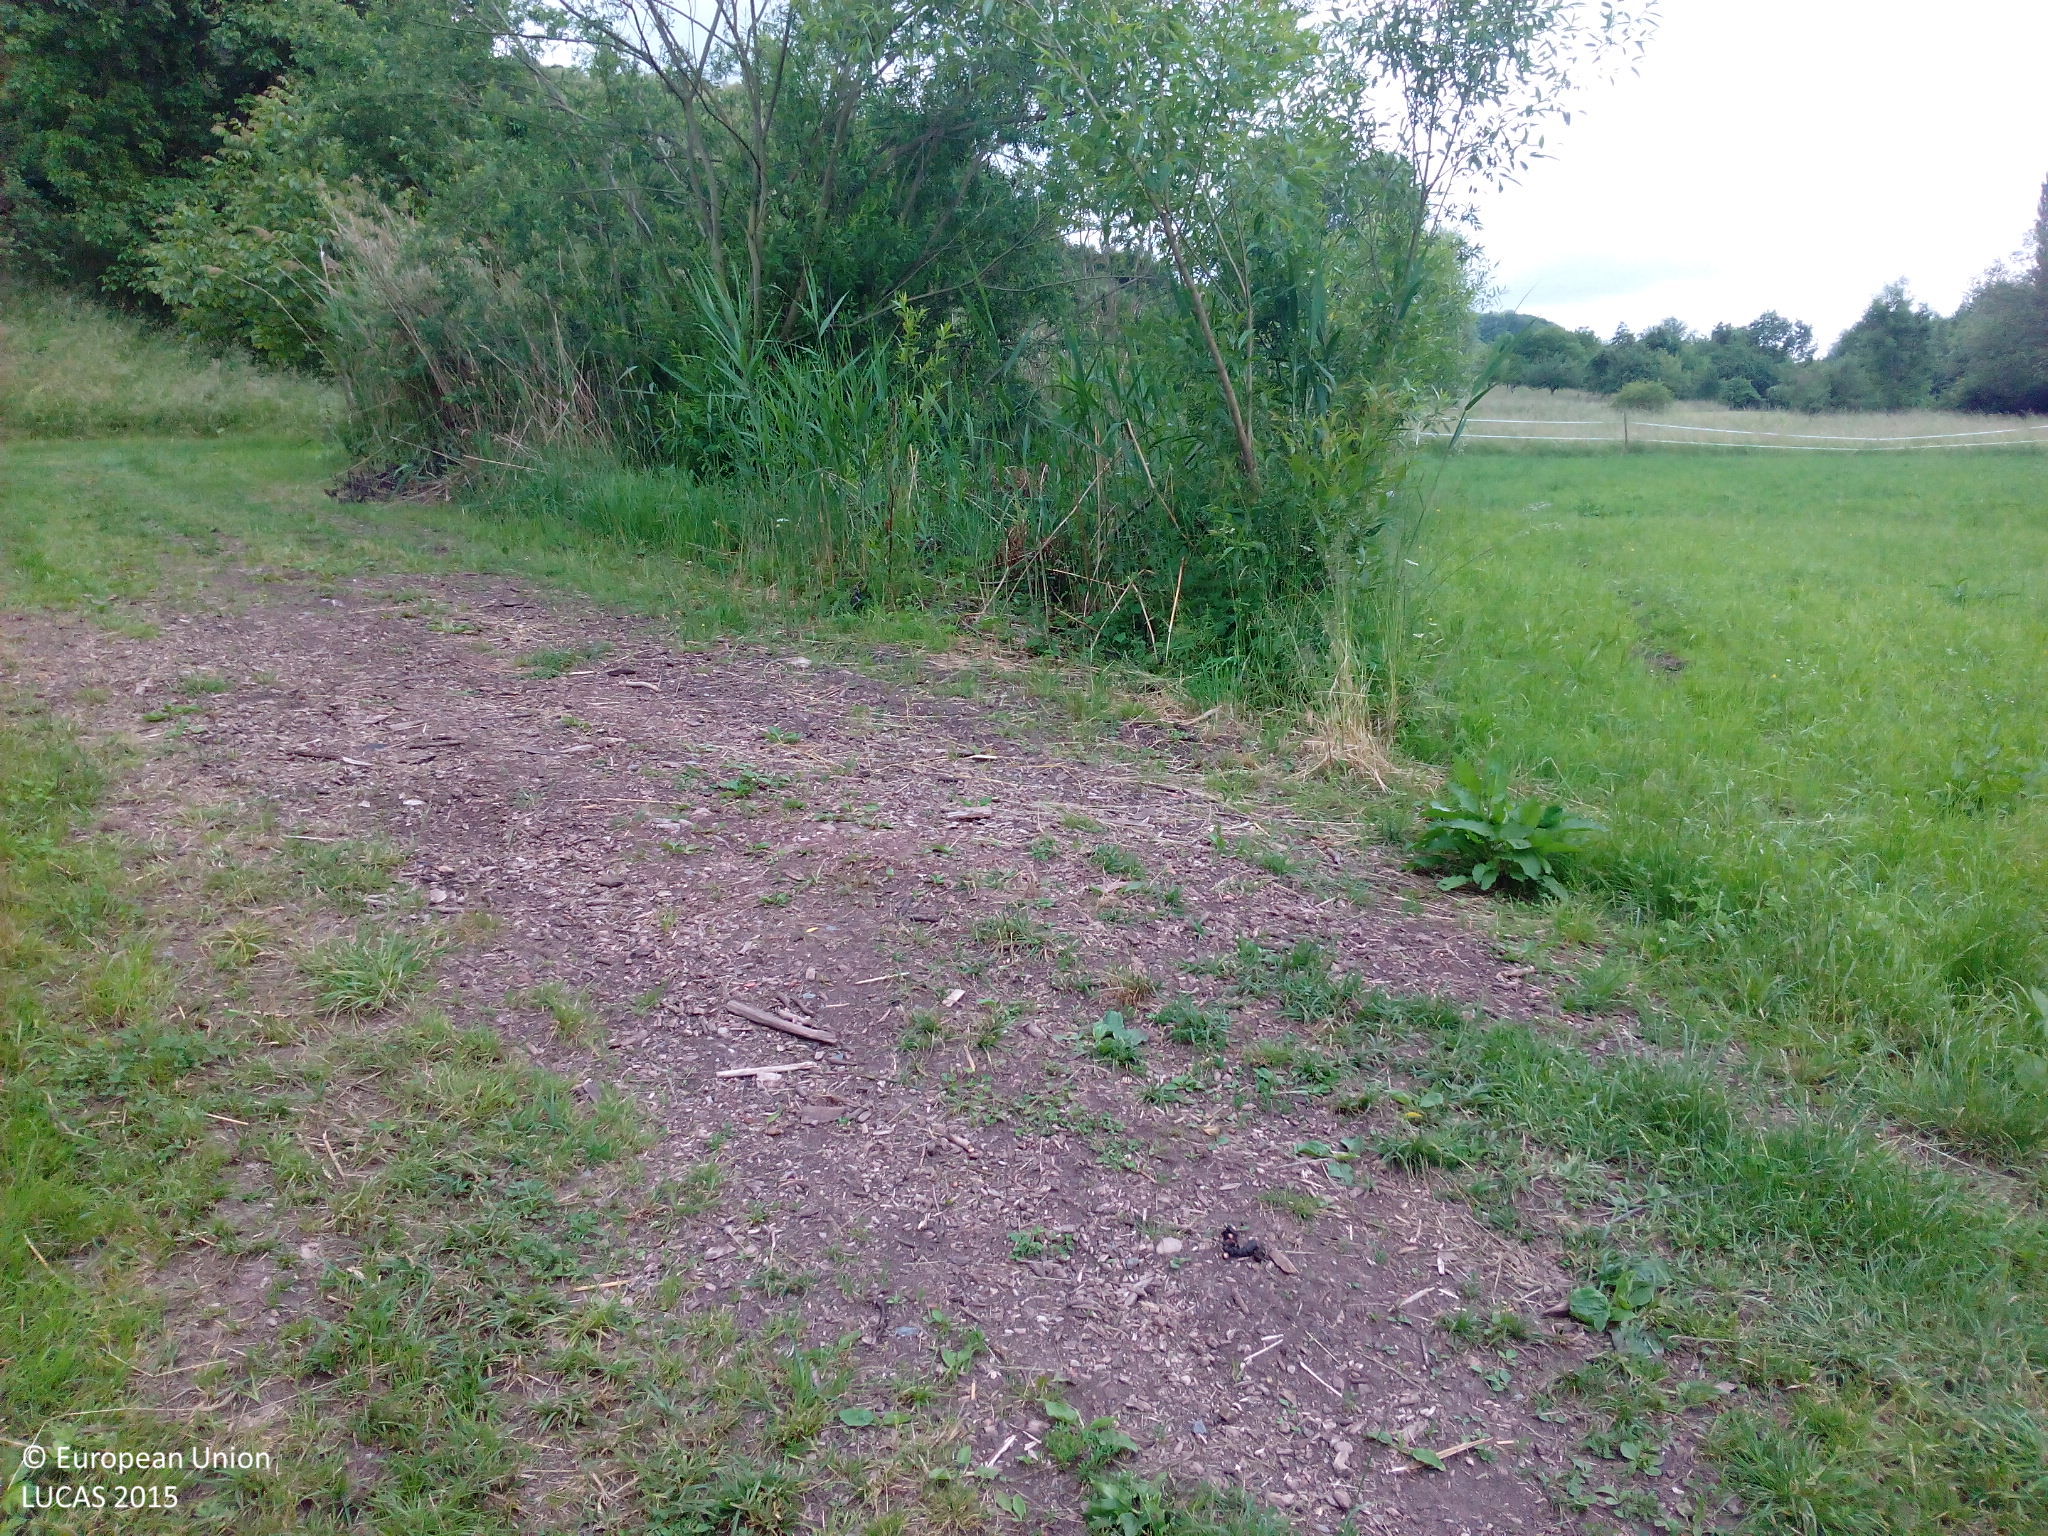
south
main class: Grassland
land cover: Grassland without tree/shrub cover
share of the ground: > 75 %
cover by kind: herbaceous plants 100 %
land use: Agriculture (excluding fallow land and kitchen gardens)
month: June
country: DE
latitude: 49.1216
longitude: 9.4111
